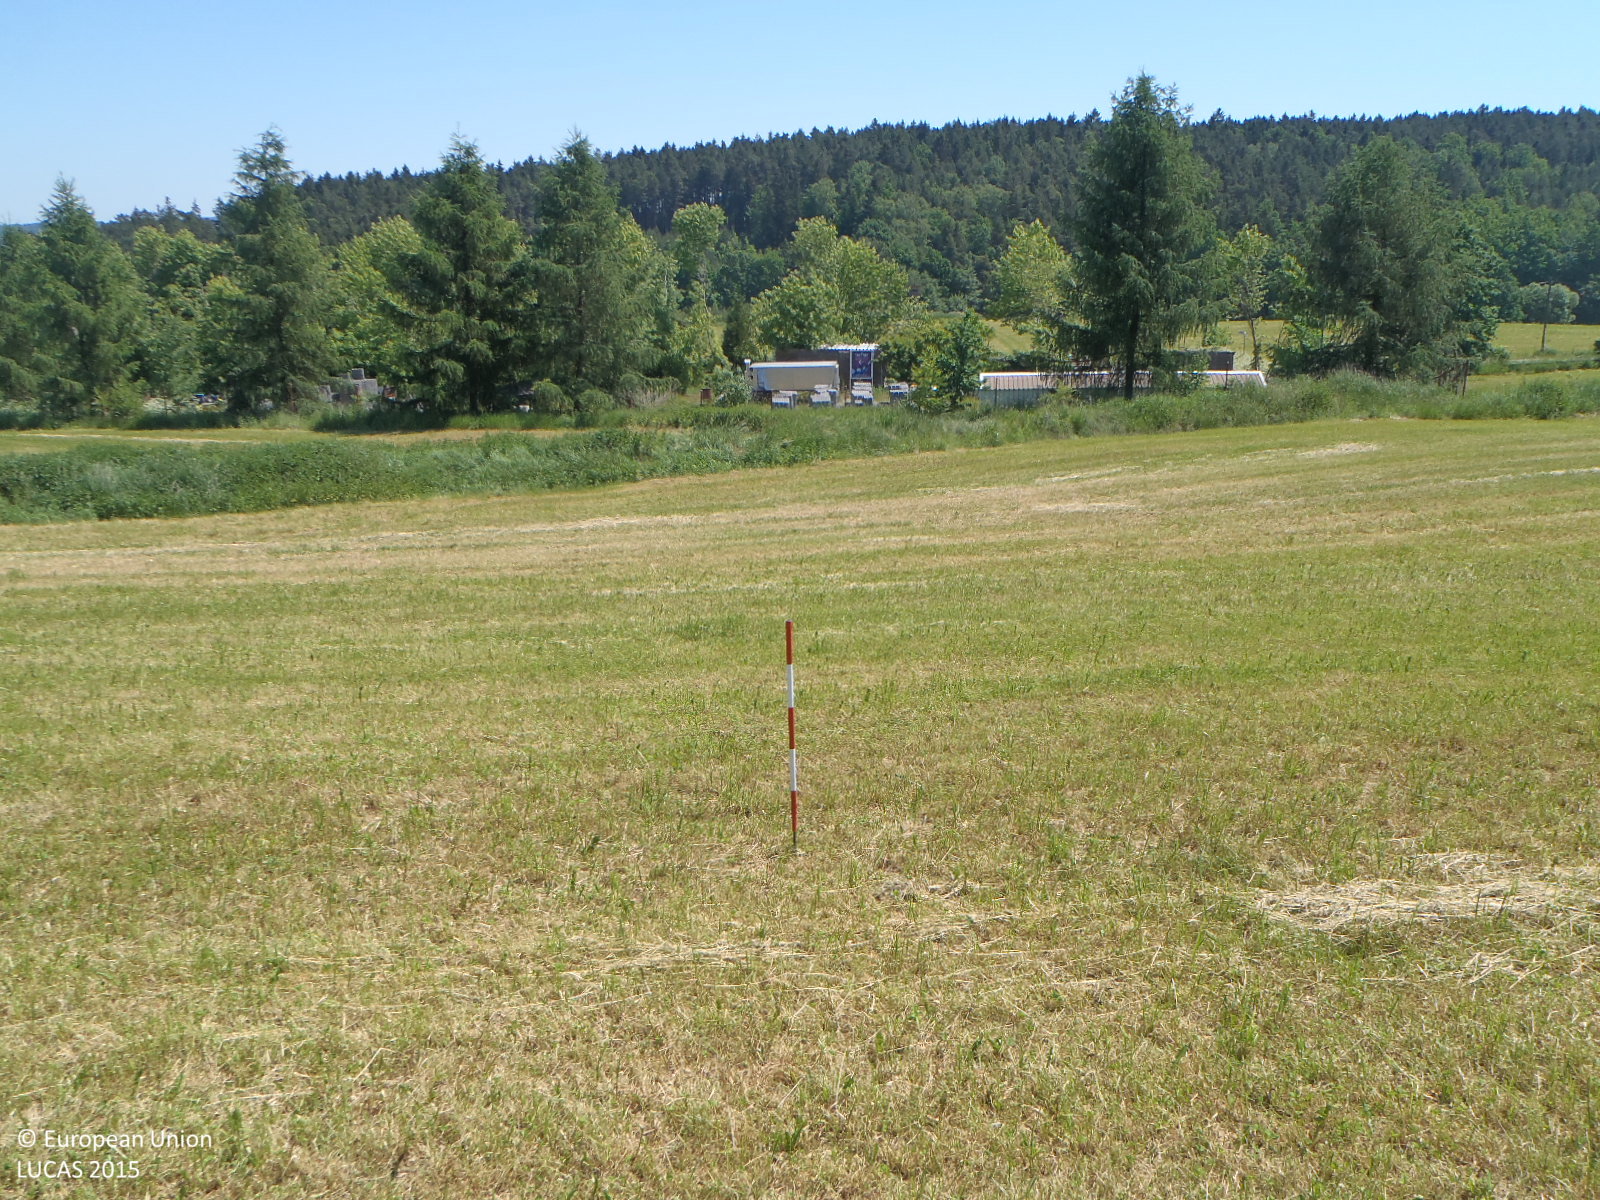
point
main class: Grassland
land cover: Grassland without tree/shrub cover
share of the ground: > 75 %
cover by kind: herbaceous plants 100 %
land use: Agriculture (excluding fallow land and kitchen gardens)
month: June
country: CZ
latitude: 48.8722
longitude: 14.4593
